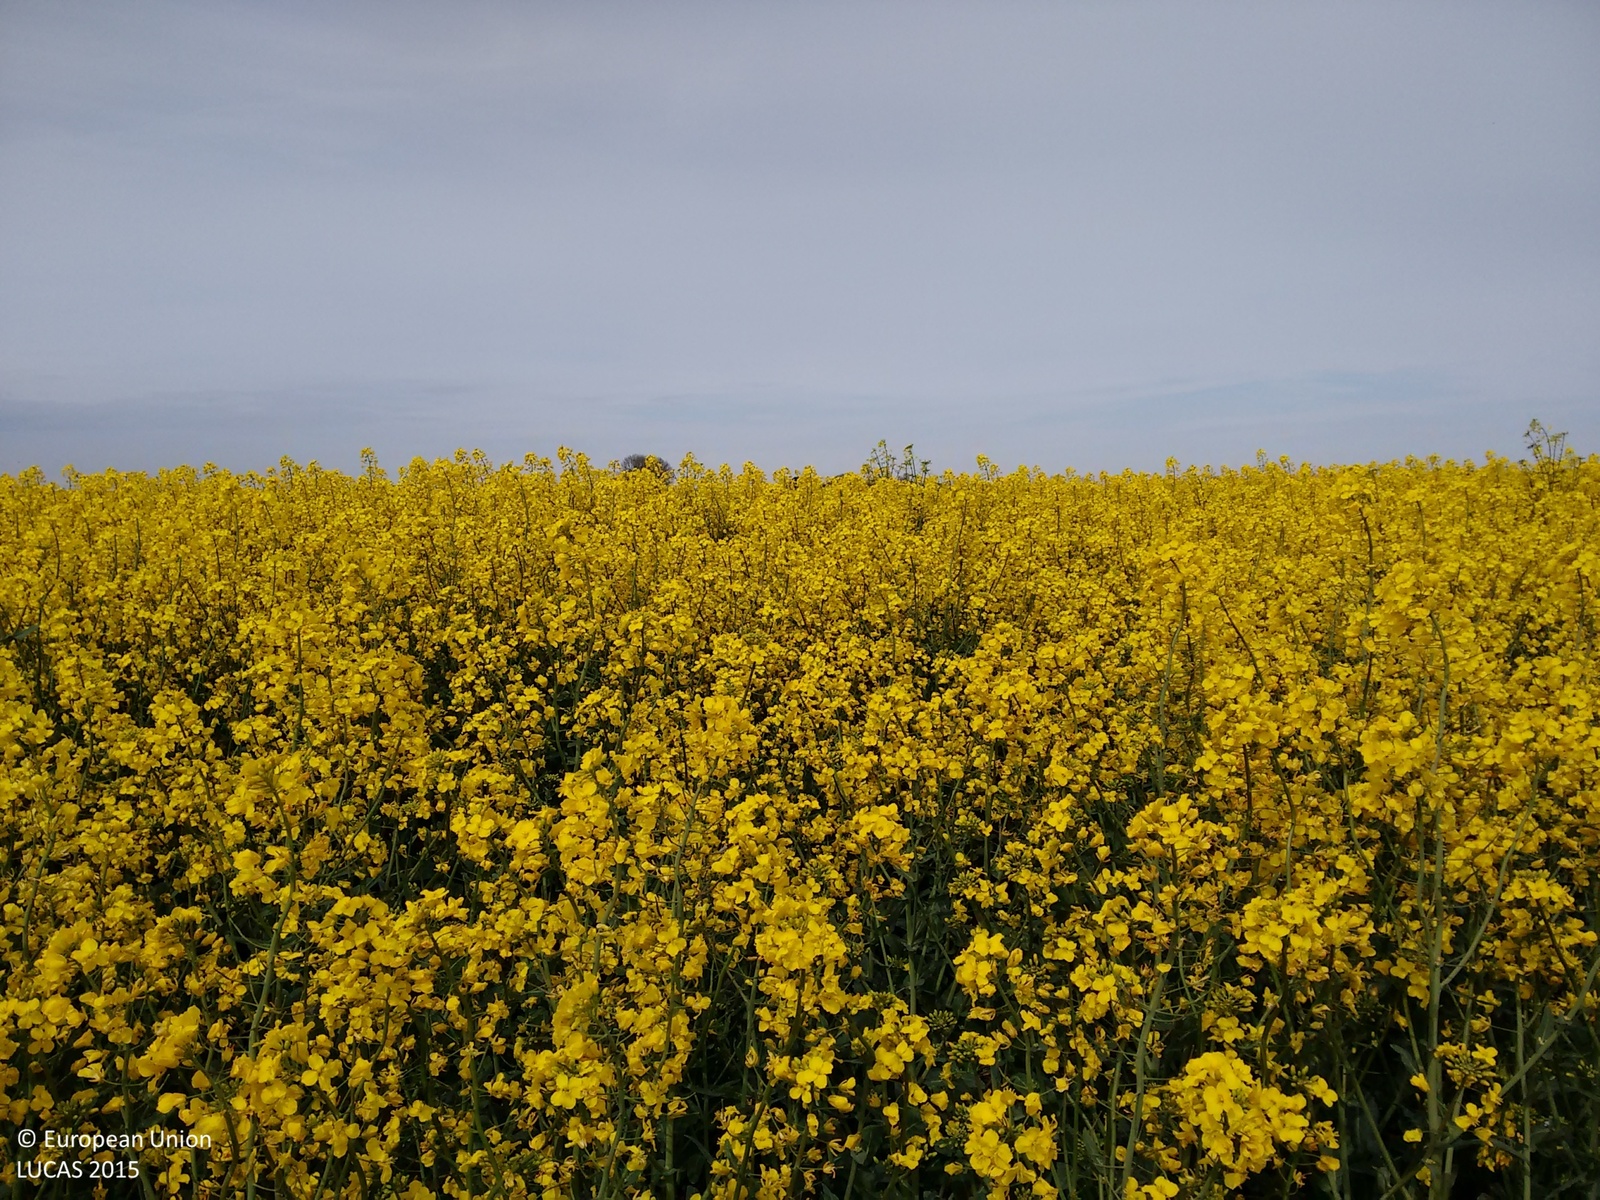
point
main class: Cropland
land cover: Rape and turnip rape
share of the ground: > 75 %
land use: Agriculture (excluding fallow land and kitchen gardens)
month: May
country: GB
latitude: 53.3090
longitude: 0.1696
